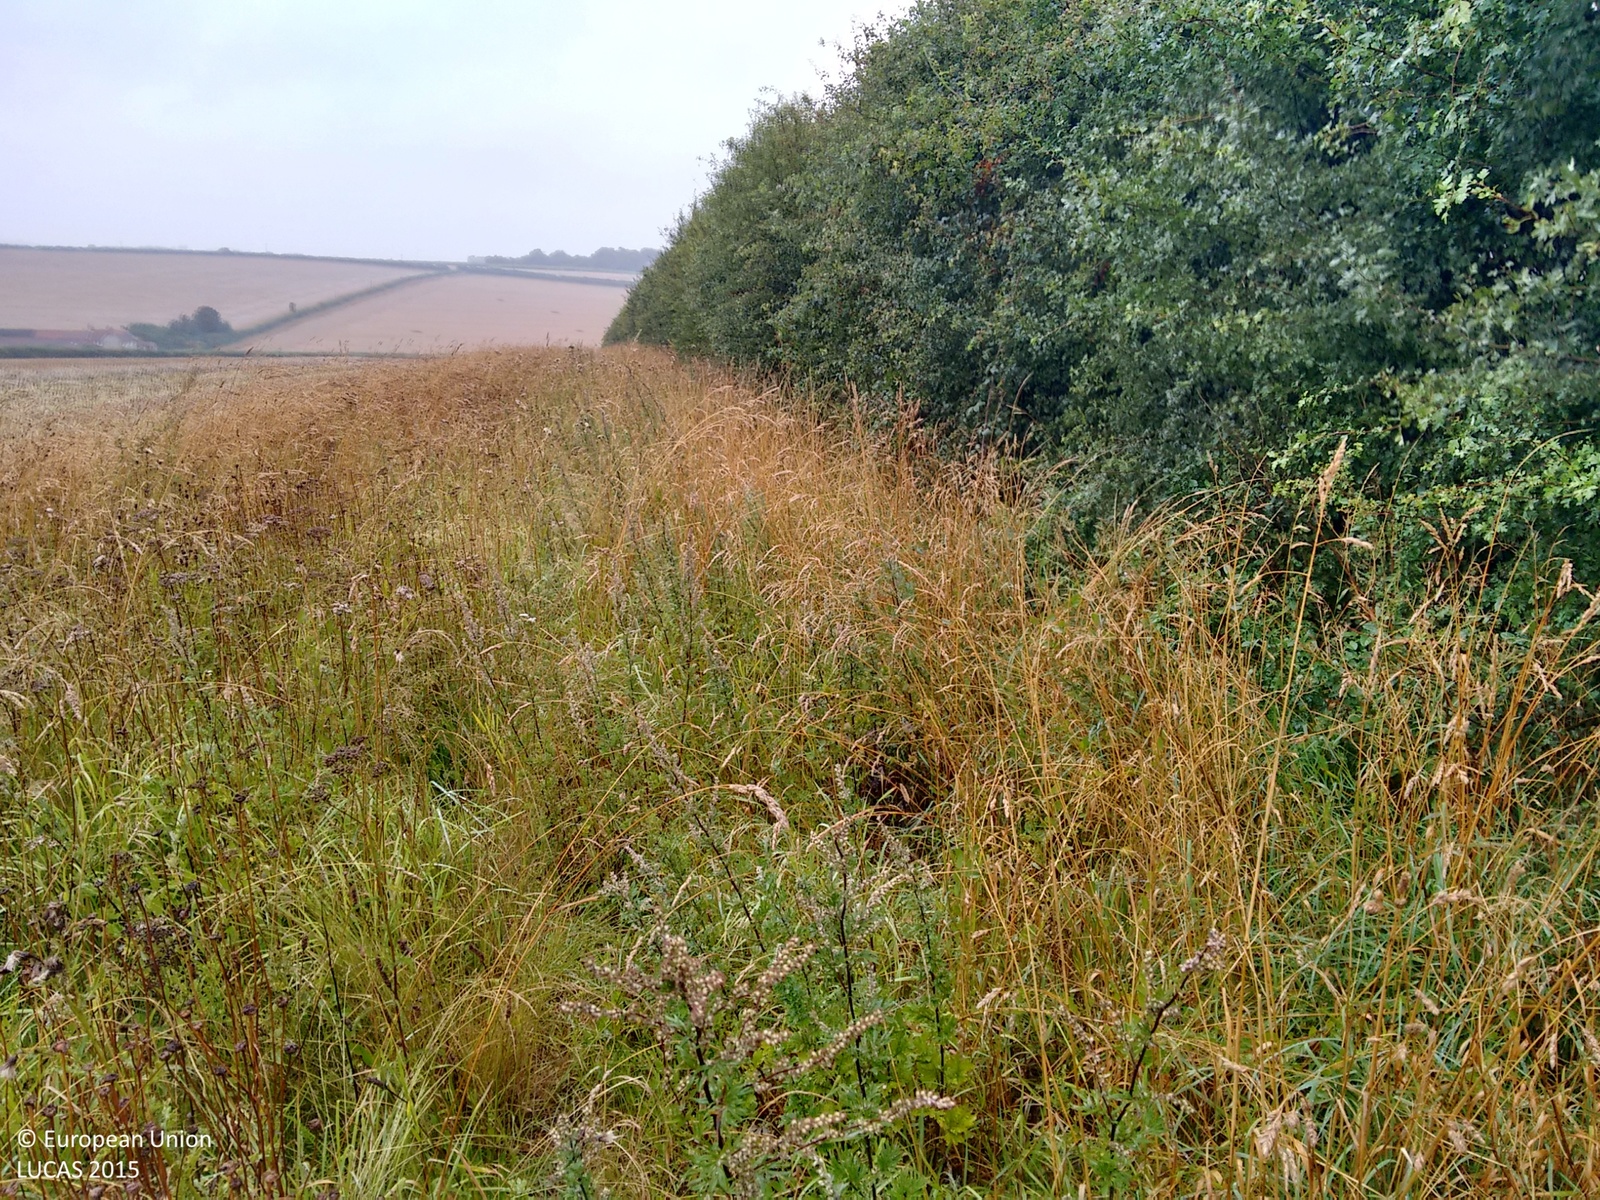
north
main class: Grassland
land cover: Spontaneously vegetated surfaces
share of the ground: > 75 %
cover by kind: herbaceous plants 100 %
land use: Agriculture (excluding fallow land and kitchen gardens)
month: August
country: GB
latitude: 52.9019
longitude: 0.7426
